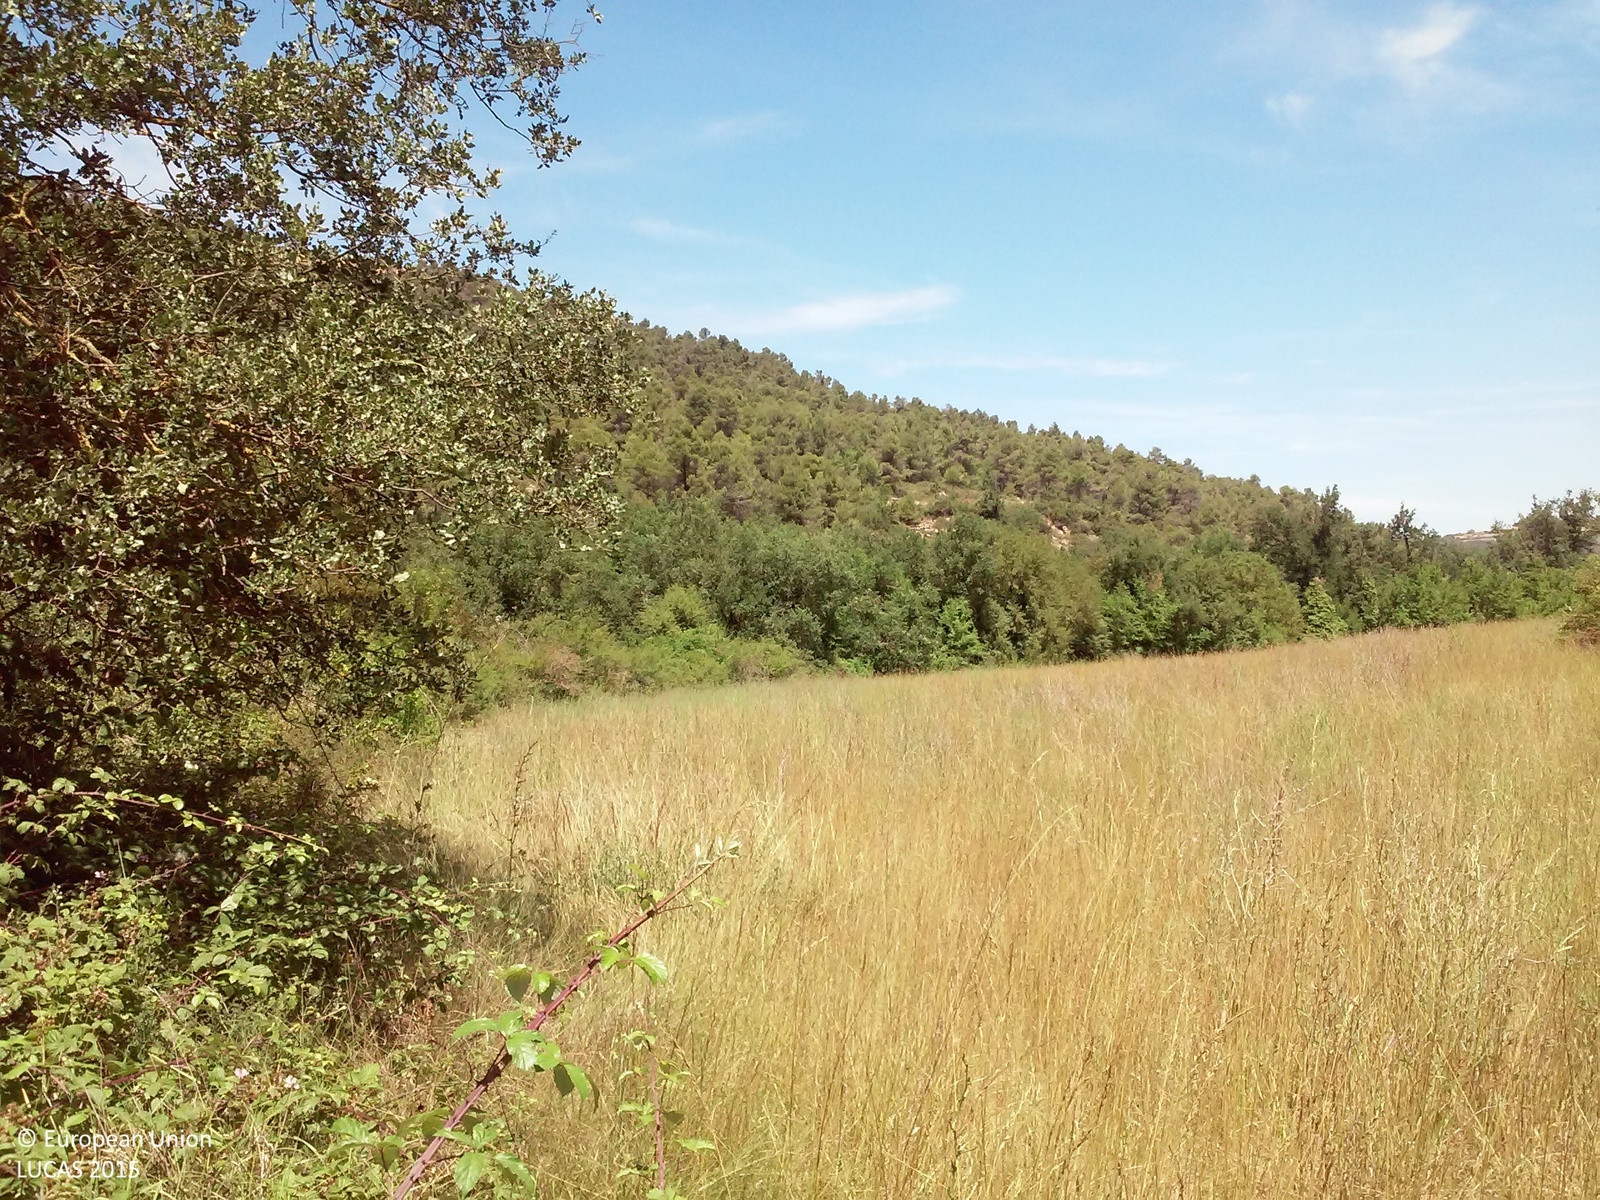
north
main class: Woodland
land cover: Broadleaved woodland
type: broadleaved evergreen forest
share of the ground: 50 - 75 %
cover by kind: herbaceous plants 40 %, broadleaved forest trees 25 %, shrubs 25 %, lichens and mosses 10 %
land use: Semi-natural and natural areas not in use
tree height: < 5 m
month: July
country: ES
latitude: 41.5284
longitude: 1.2300
